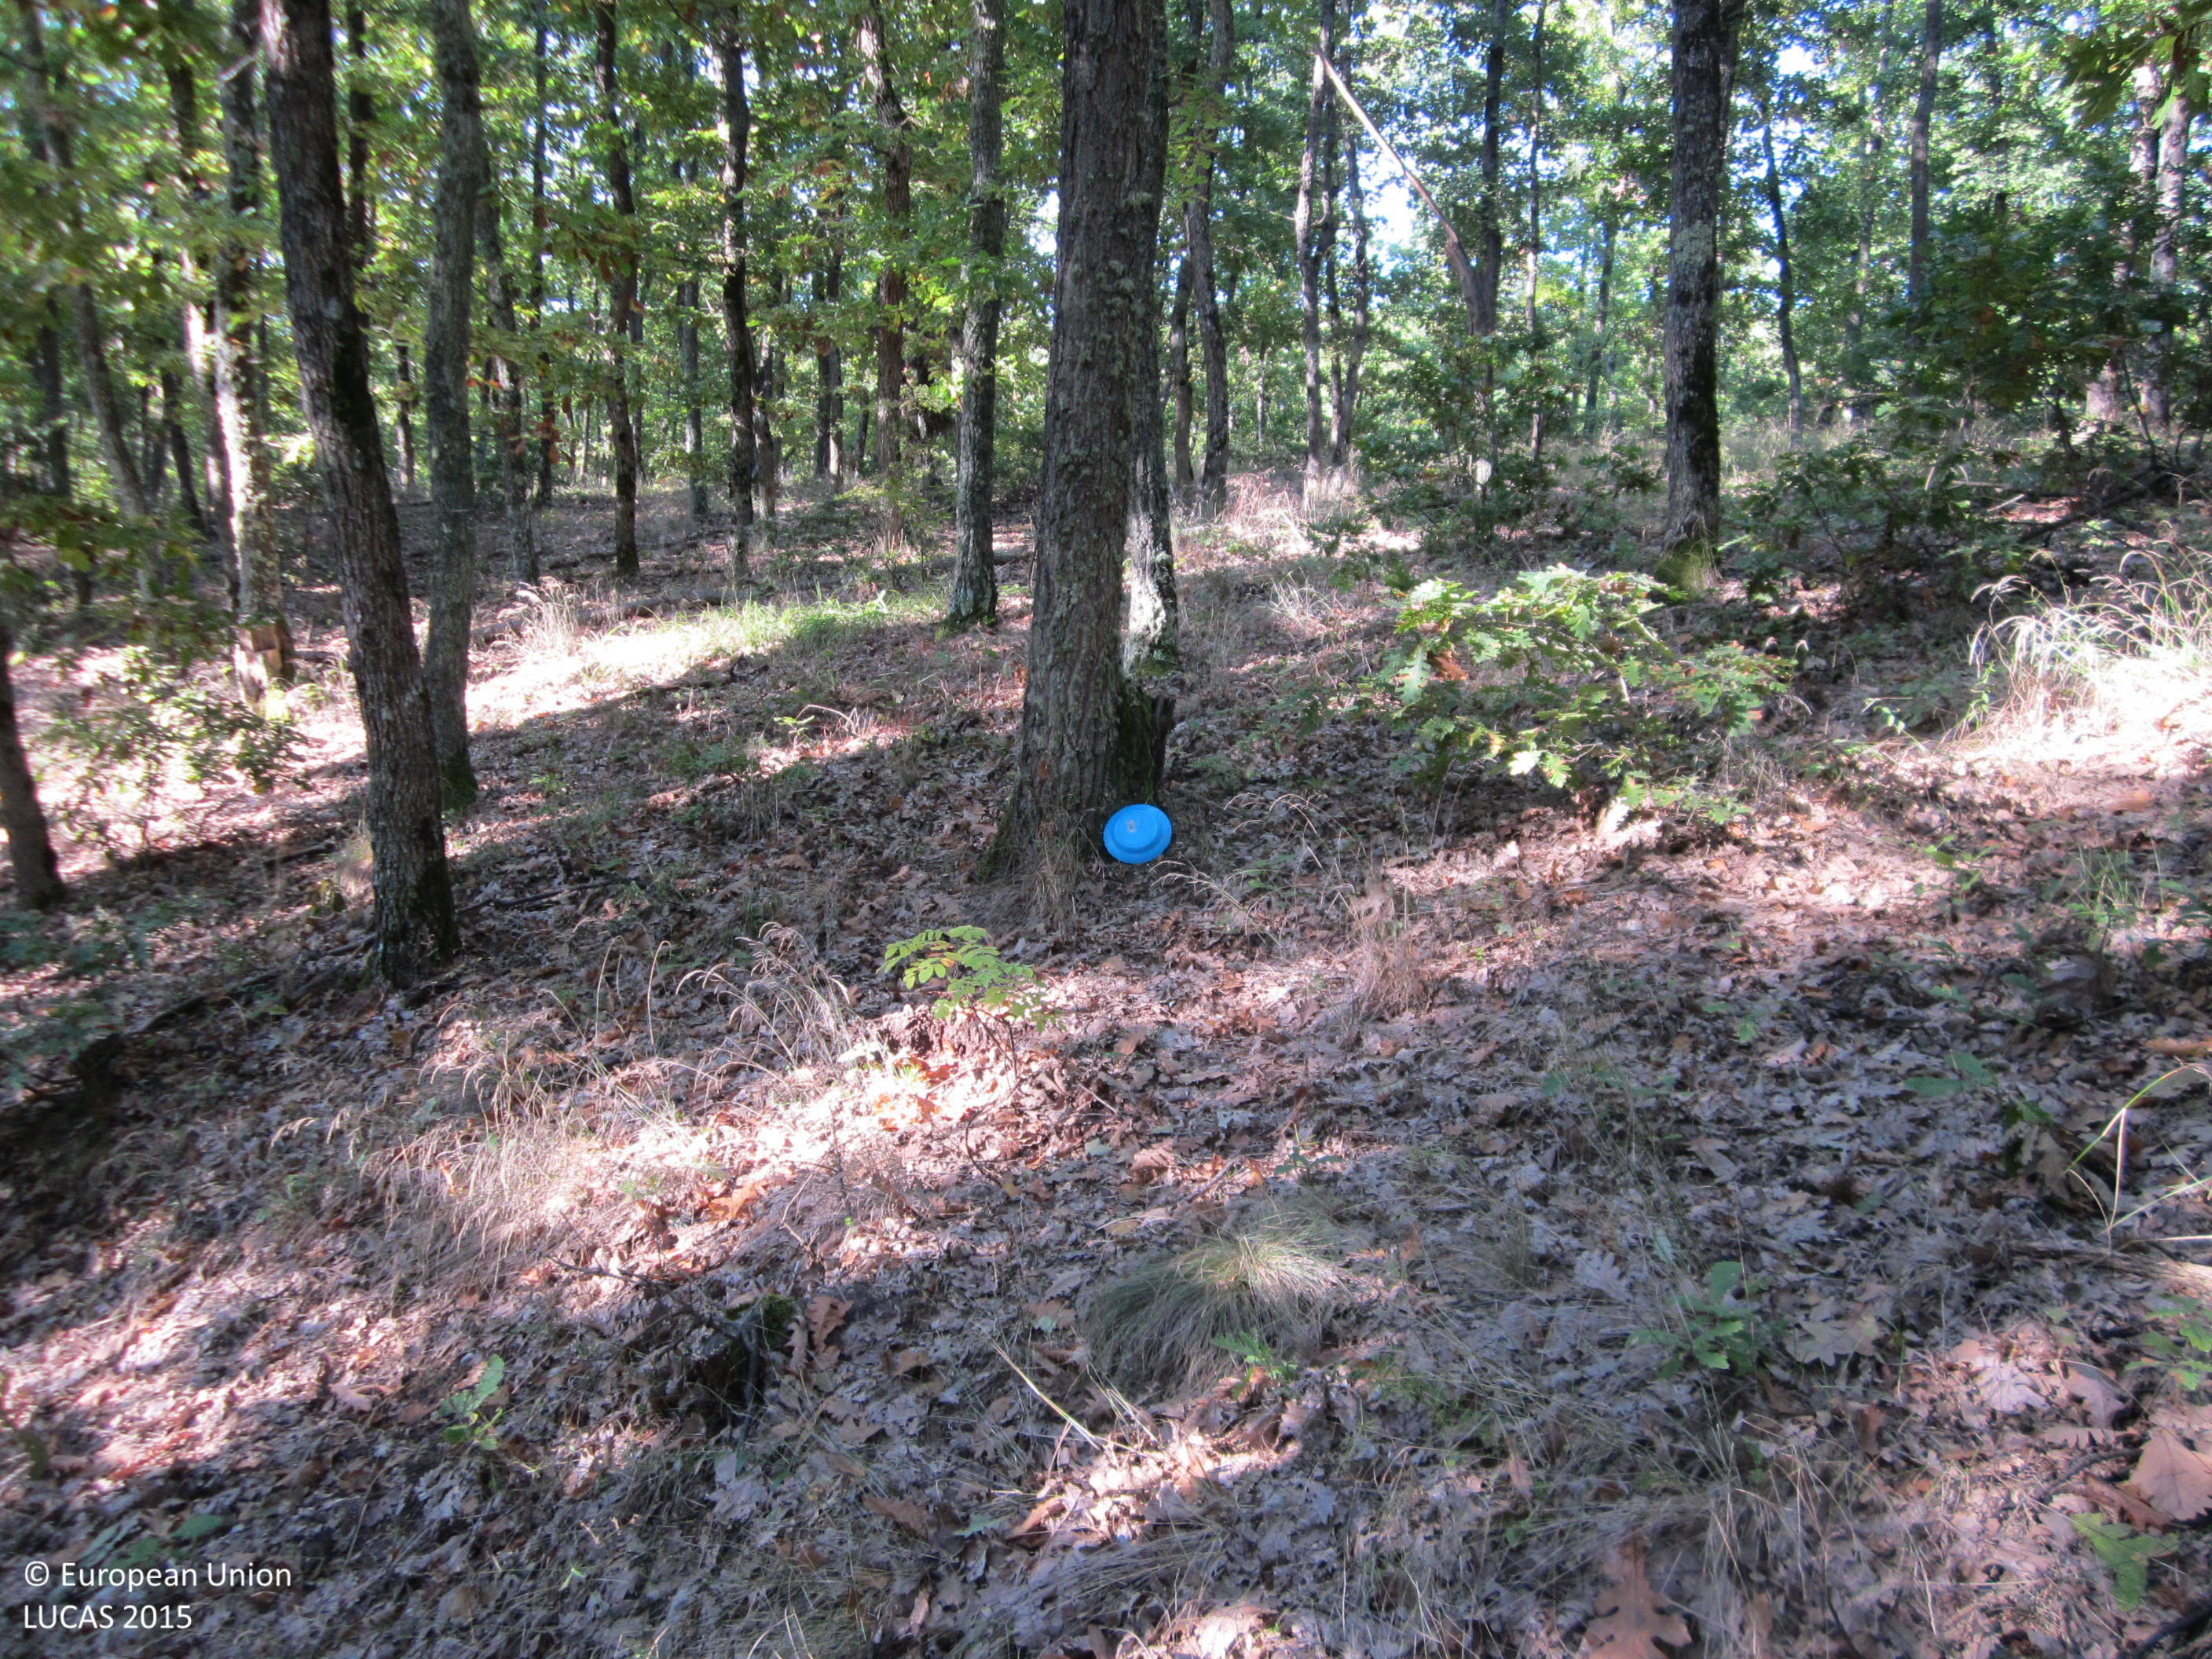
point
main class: Woodland
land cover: Broadleaved woodland
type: acidophilous oak and oak-birch forest
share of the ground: 50 - 75 %
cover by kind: broadleaved forest trees 70 %, unconsolidated bare surface 25 %, herbaceous plants 5 %
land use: Forestry
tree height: > 5 m
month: October
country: BG
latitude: 42.7891
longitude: 26.6649
